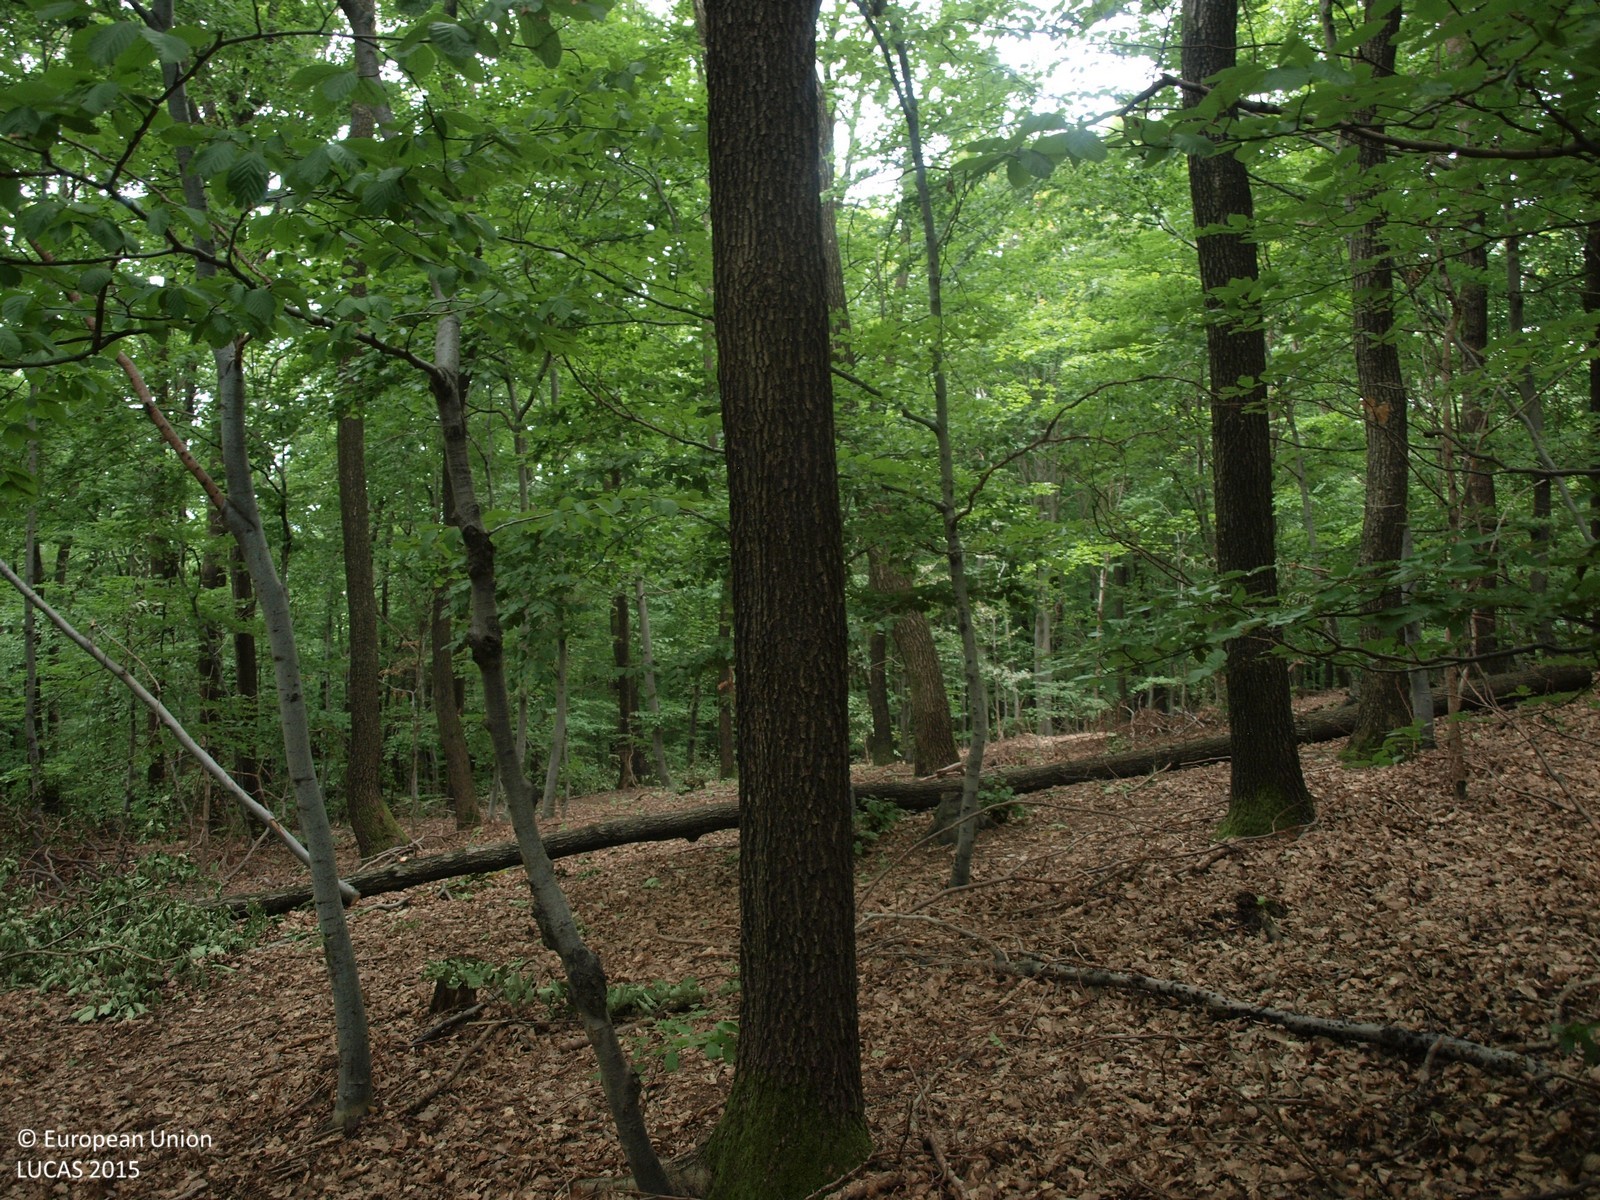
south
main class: Woodland
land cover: Broadleaved woodland
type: mesophytic deciduous forest
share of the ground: > 75 %
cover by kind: broadleaved forest trees 100 %
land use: Forestry
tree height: > 5 m
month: August
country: HR
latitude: 45.8447
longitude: 15.9081
